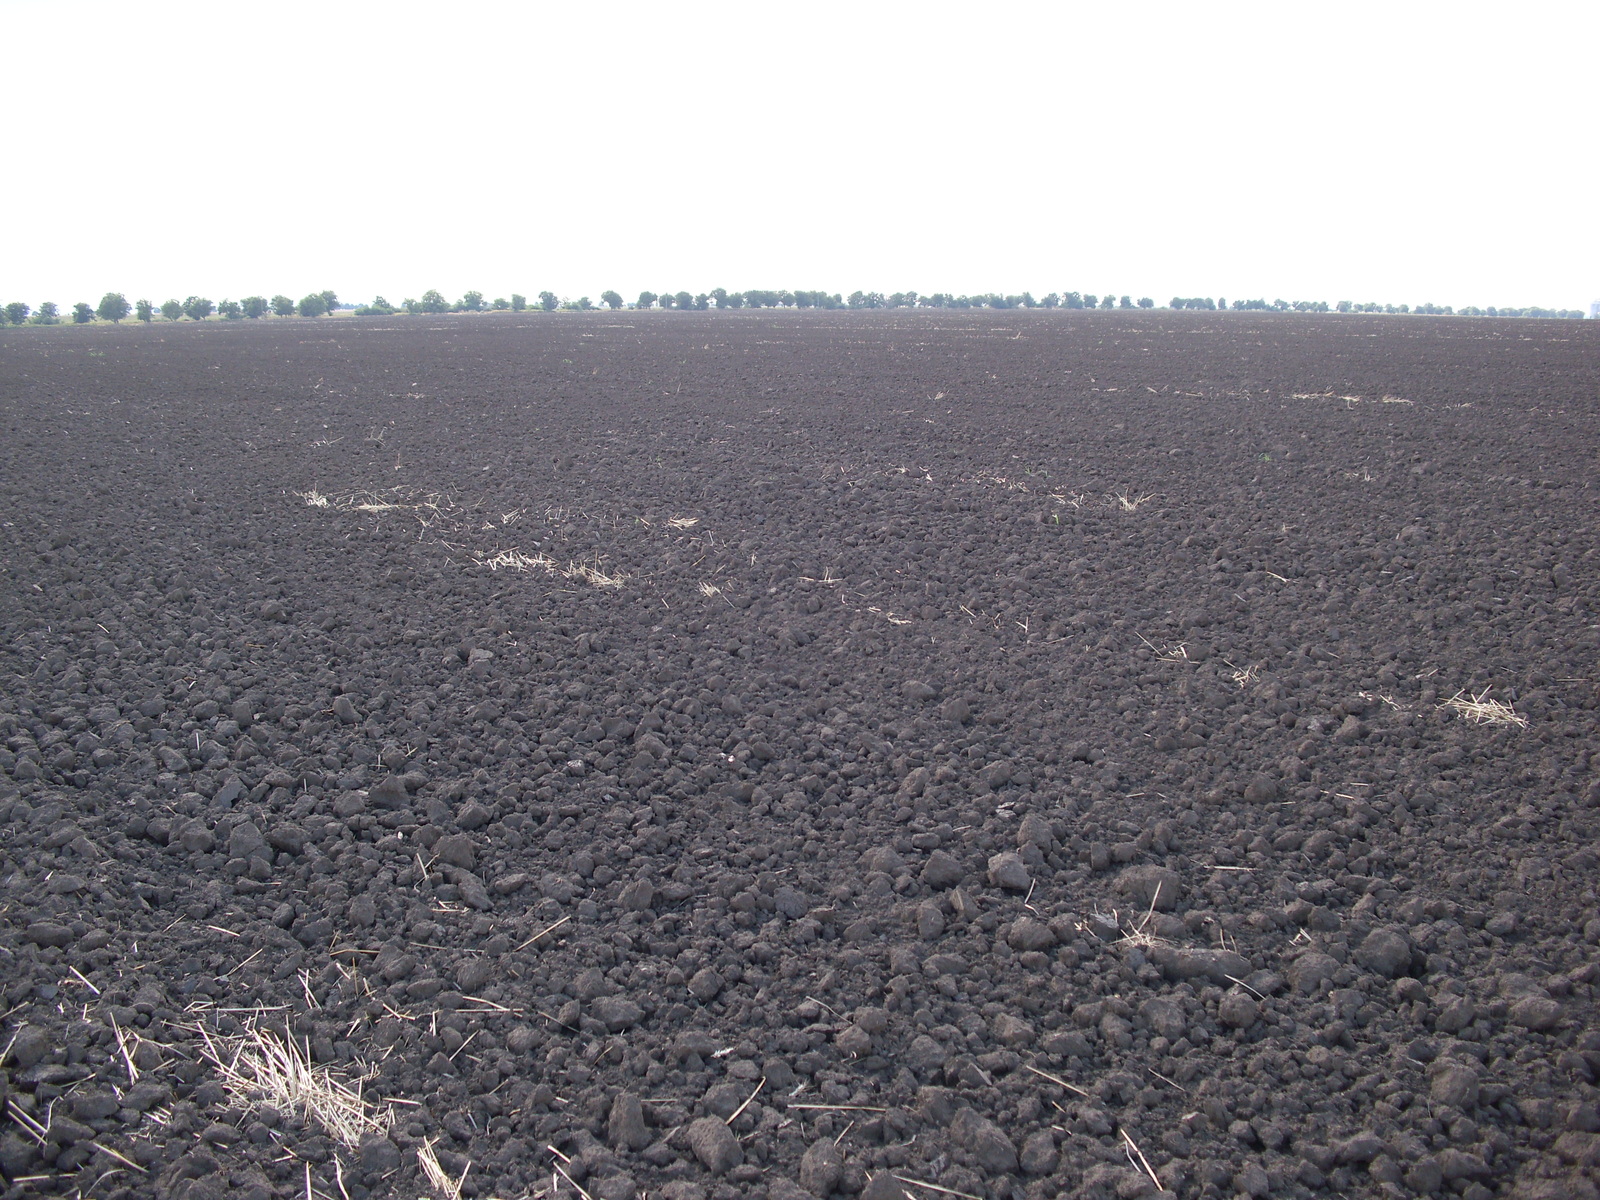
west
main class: Cropland
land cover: Common wheat
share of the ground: < 10 %
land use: Agriculture (excluding fallow land and kitchen gardens)
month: August
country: BG
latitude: 43.7466
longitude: 23.2938
